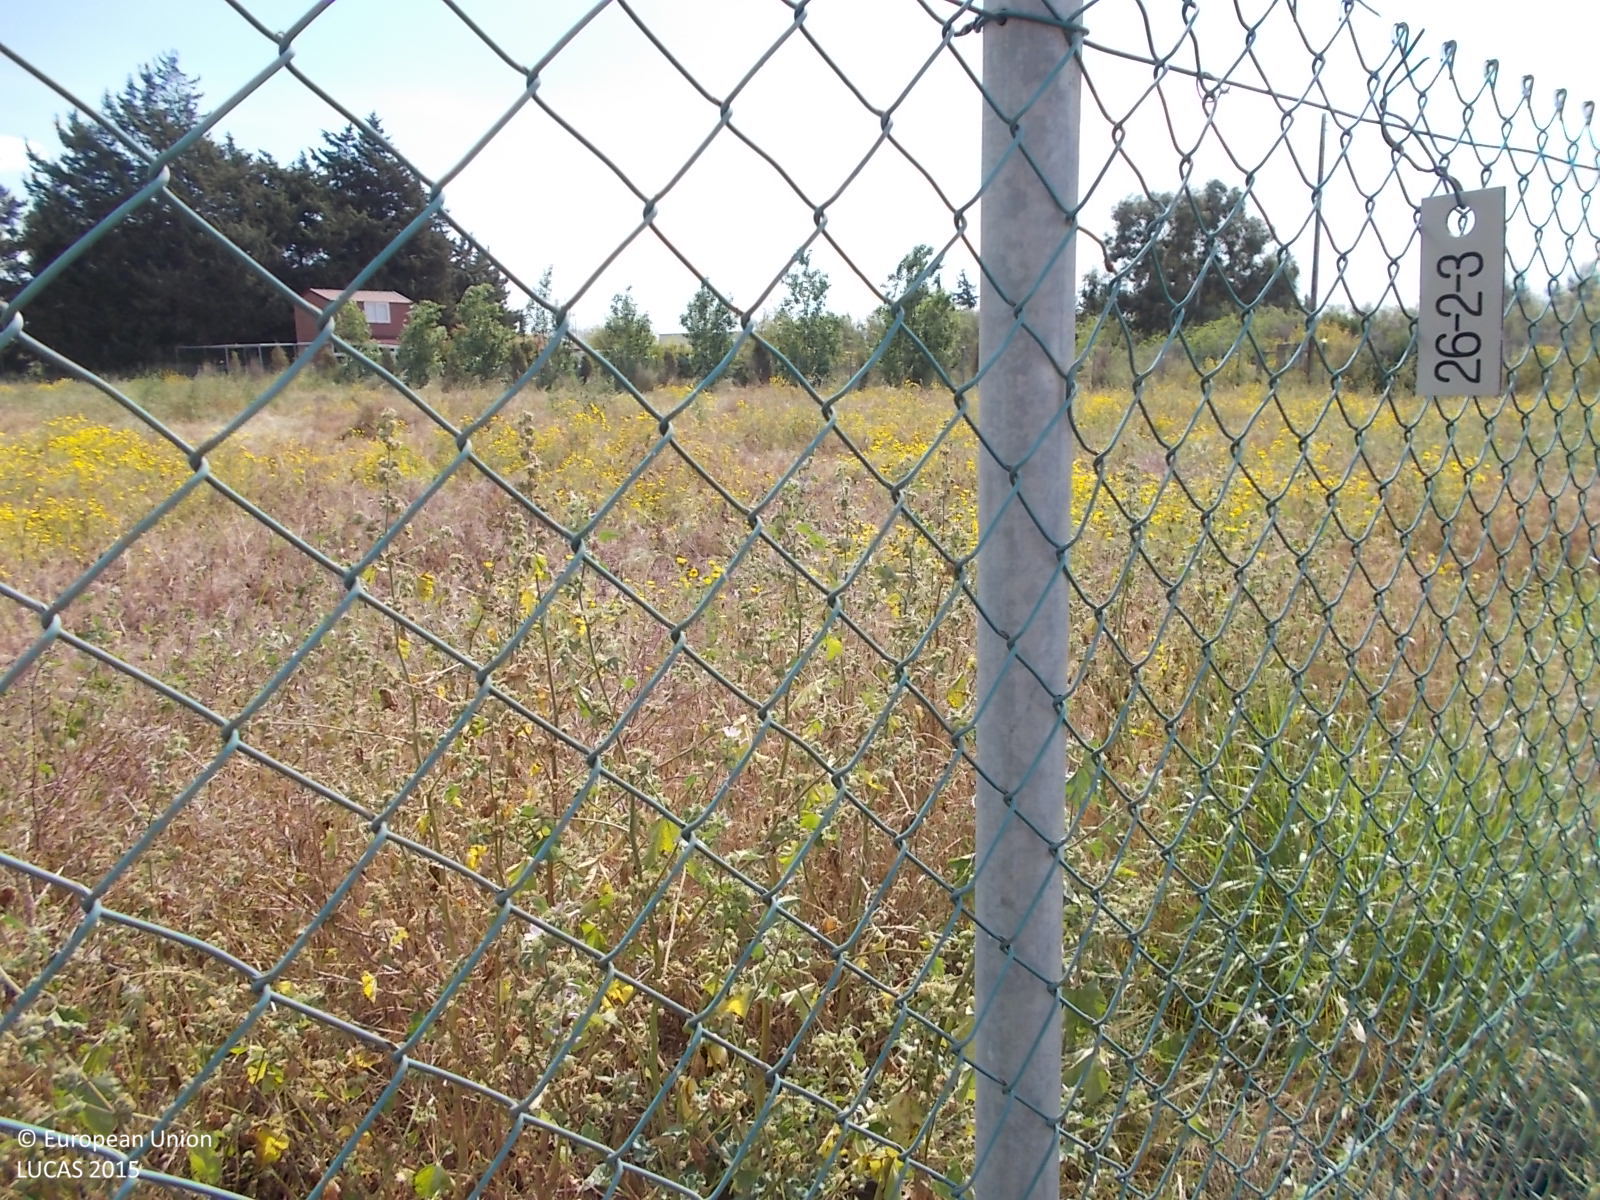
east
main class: Grassland
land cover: Grassland without tree/shrub cover
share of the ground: > 75 %
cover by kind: herbaceous plants 100 %
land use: Agriculture (excluding fallow land and kitchen gardens)
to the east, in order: Grassland without tree/shrub cover; Fences; Artificial constructions in urban areas; Managed hedges; Spontaneously vegetated surfaces; Managed hedges; Ditches and canals; Spontaneously vegetated surfaces; Lines of trees; Spontaneously vegetated surfaces; Fences; Lines of trees; Grassland without tree/shrub cover; Tracks; Fences; Mixed cereals for fodder
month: April
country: CY
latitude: 34.8369
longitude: 33.5590
